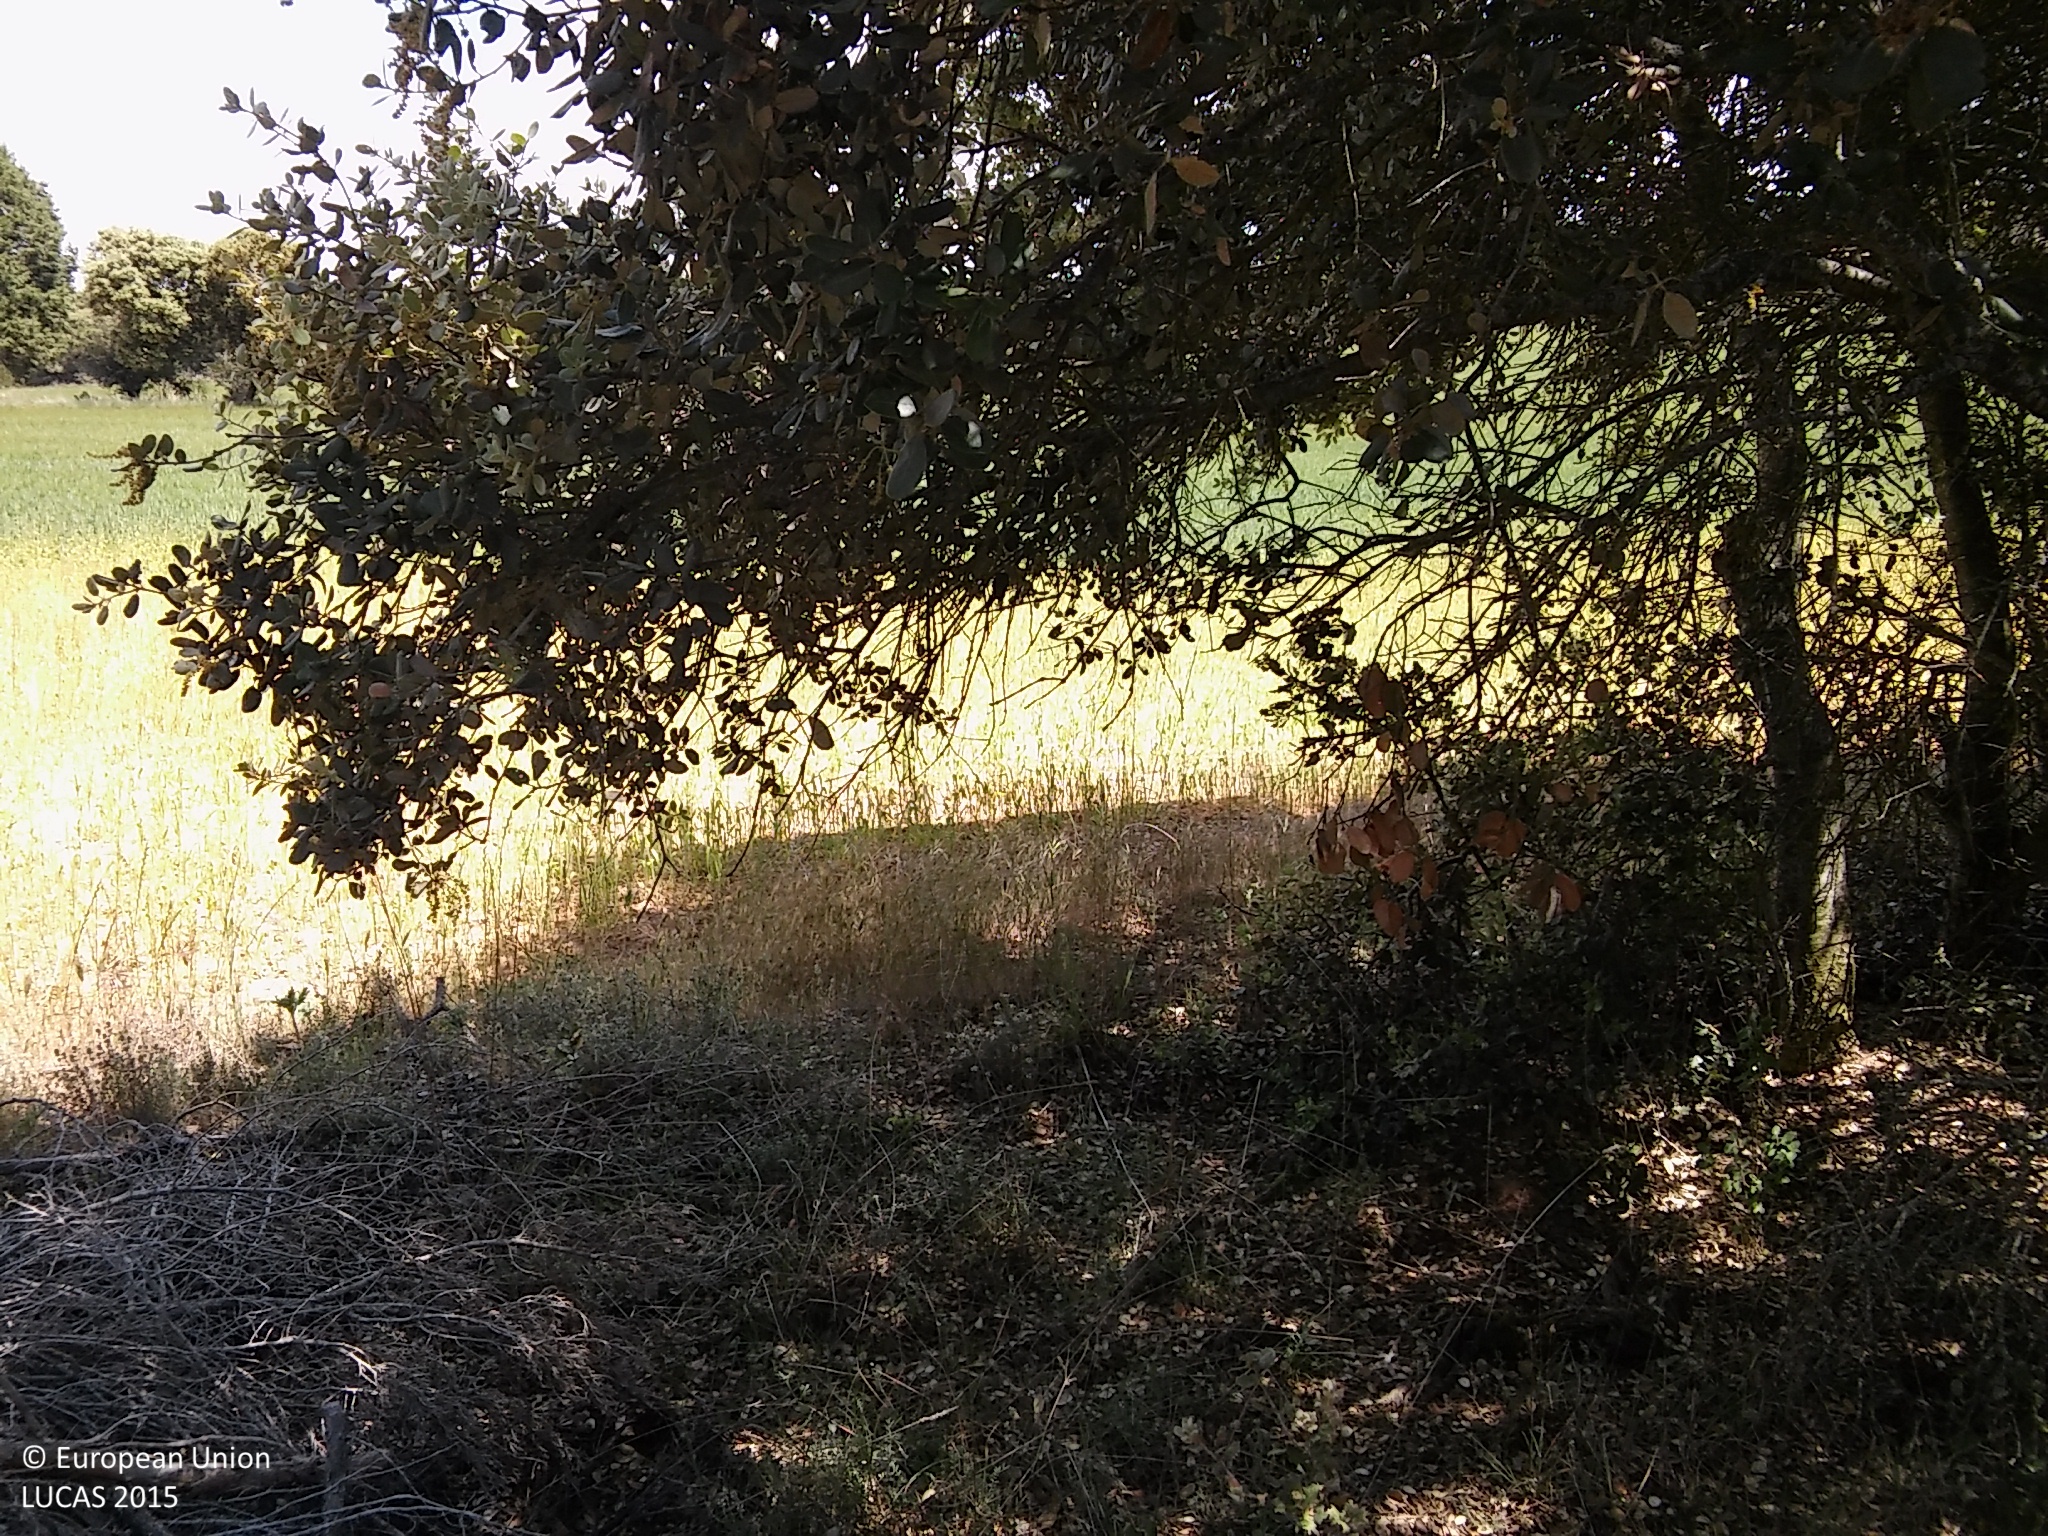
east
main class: Woodland
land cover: Other mixed woodland
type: coniferous forest of the mediterranean region
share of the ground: 25 - 50 %
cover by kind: coniferous forest trees 25 %, broadleaved forest trees 25 %, shrubs 25 %, unconsolidated bare surface 15 %, herbaceous plants 10 %
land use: Forestry
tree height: > 5 m
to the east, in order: Other mixed woodland; Barley; Other mixed woodland; Ditches and canals; Grass margins; Tracks
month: May
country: ES
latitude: 41.6075
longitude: -3.5736
